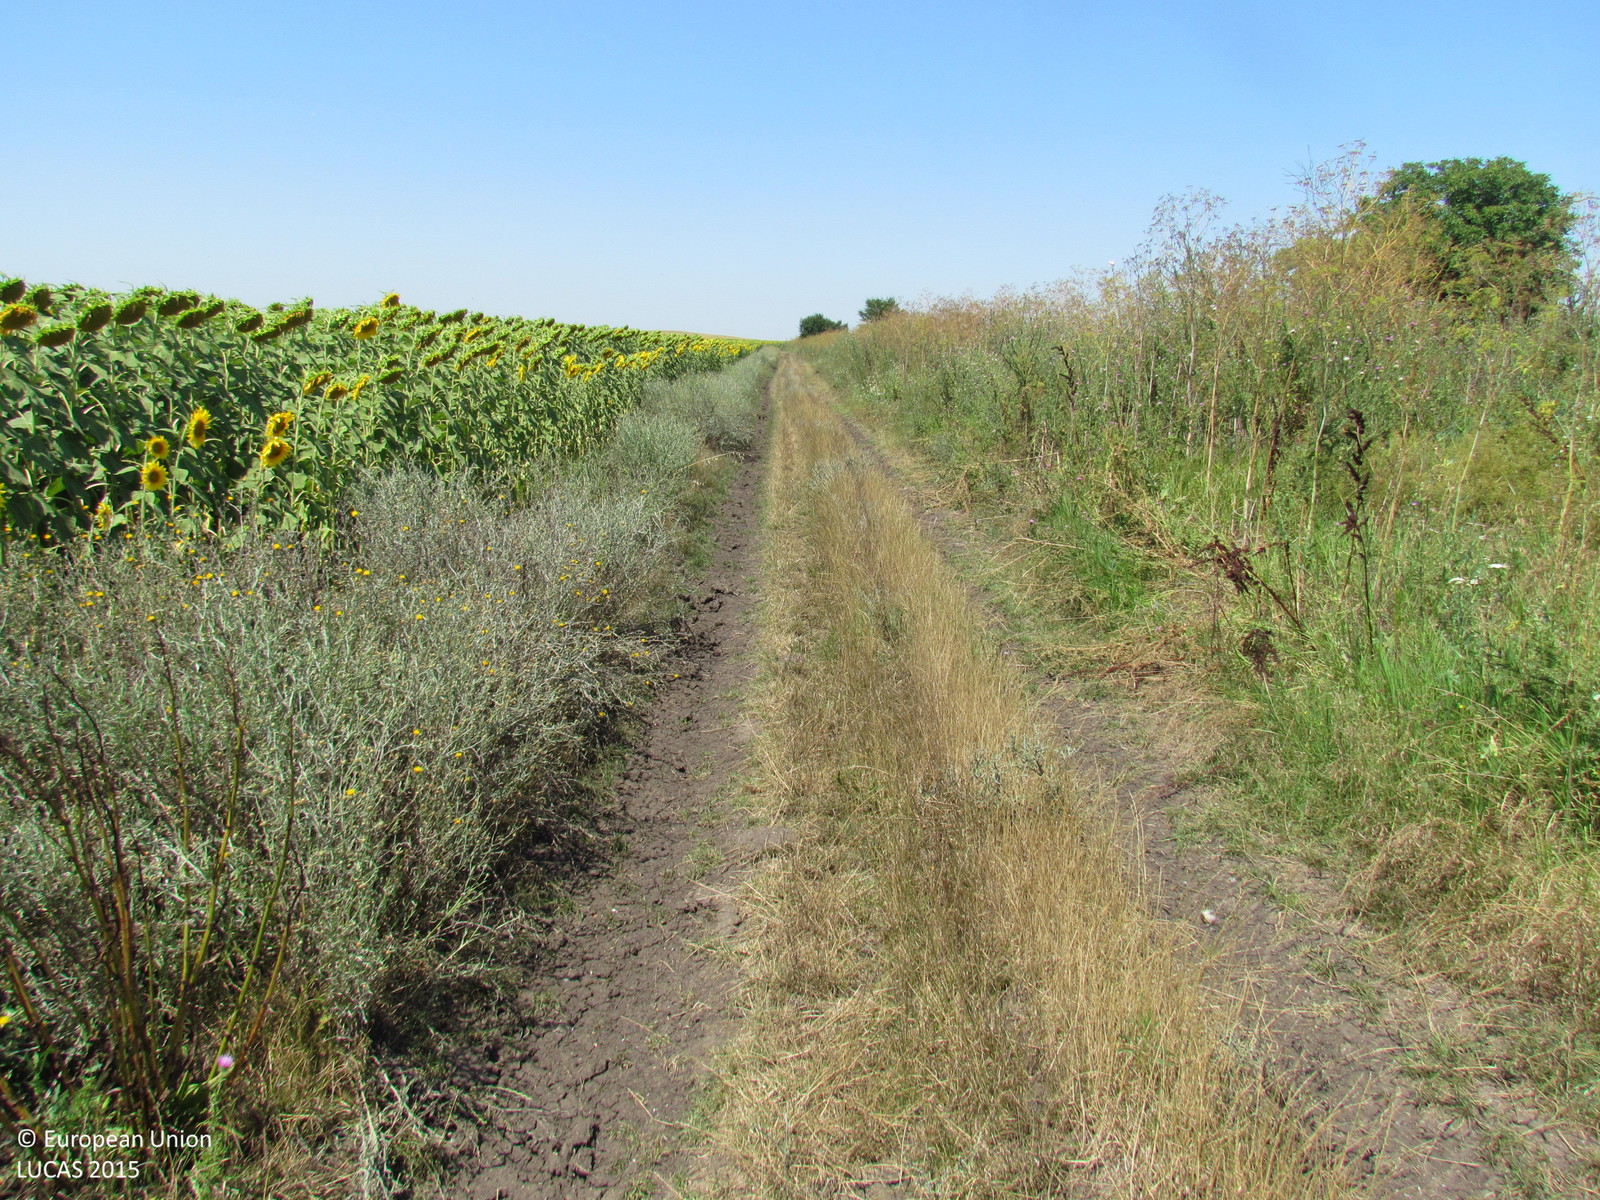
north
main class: Cropland
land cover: Sunflower
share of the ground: > 75 %
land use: Agriculture (excluding fallow land and kitchen gardens)
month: July
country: BG
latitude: 42.4260
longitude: 27.2849
